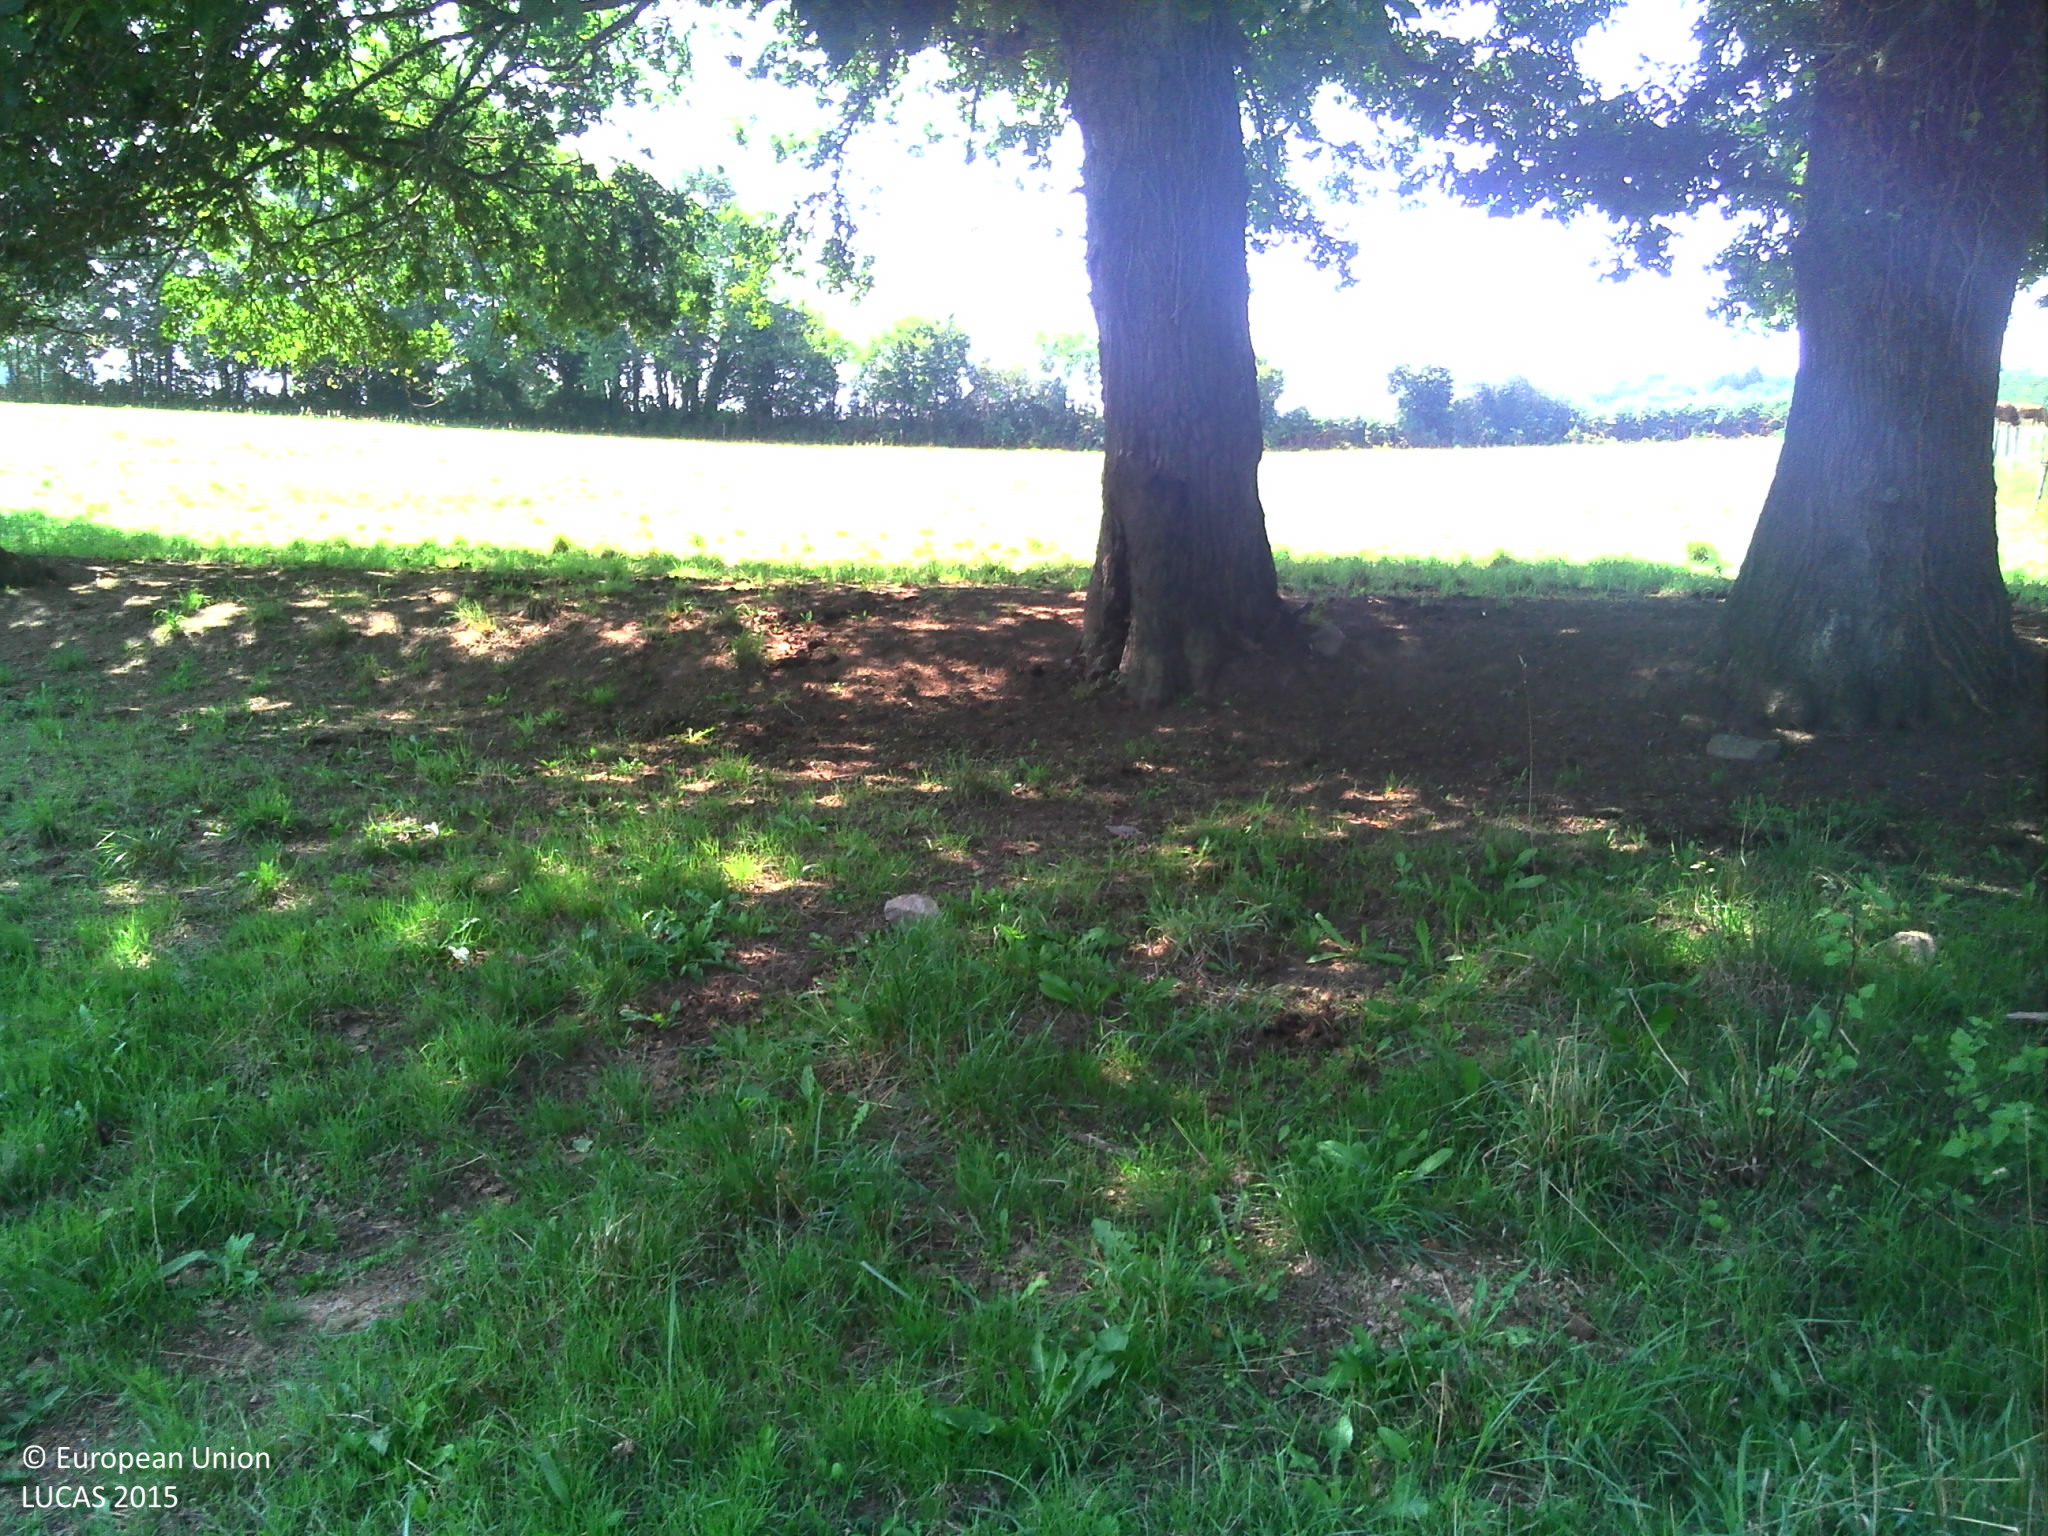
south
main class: Grassland
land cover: Grassland without tree/shrub cover
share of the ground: > 75 %
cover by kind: herbaceous plants 100 %
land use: Agriculture (excluding fallow land and kitchen gardens)
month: August
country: FR
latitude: 46.2596
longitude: 1.6497
